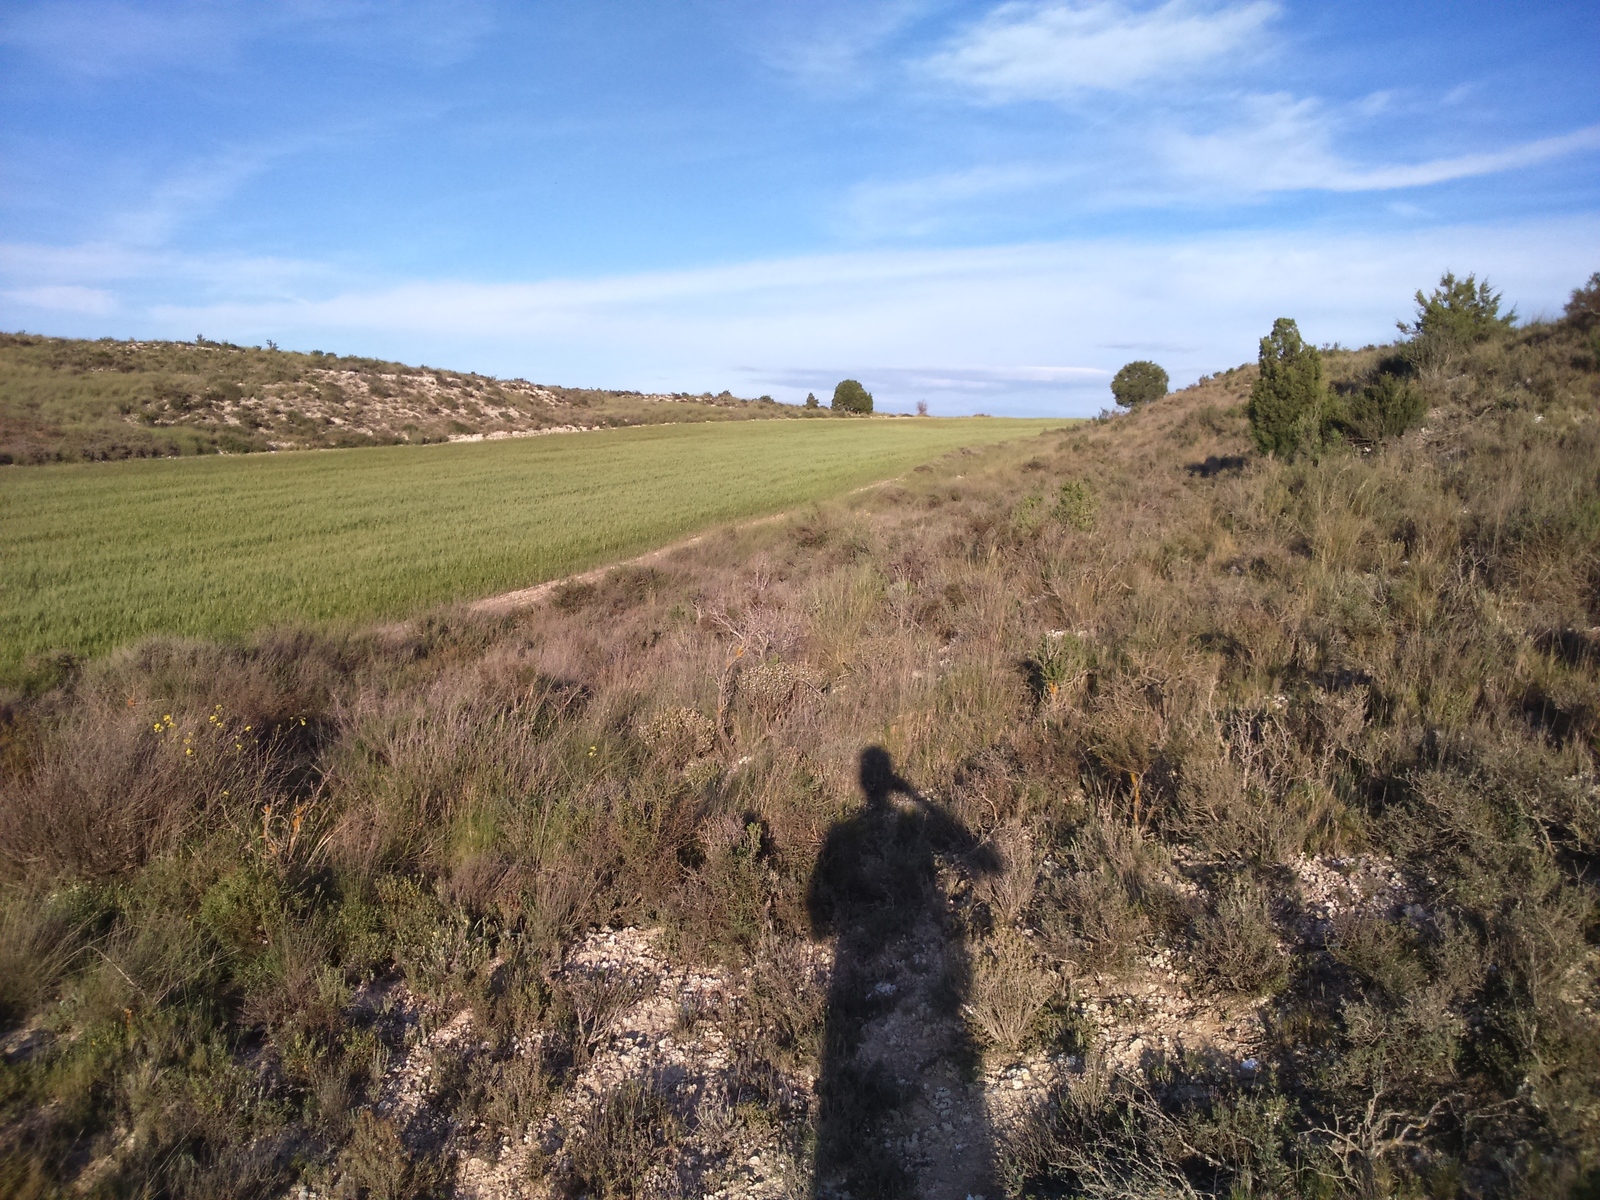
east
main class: Shrubland
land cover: Shrubland with sparse tree cover
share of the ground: > 75 %
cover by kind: shrubs 80 %, herbaceous plants 15 %, coniferous forest trees 5 %
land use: Semi-natural and natural areas not in use
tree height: < 5 m
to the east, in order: Shrubland with sparse tree cover; Durum wheat; Shrubland without tree cover; Other bare soil; Shrubland without tree cover
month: April
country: ES
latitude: 41.4340
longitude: -0.3198
